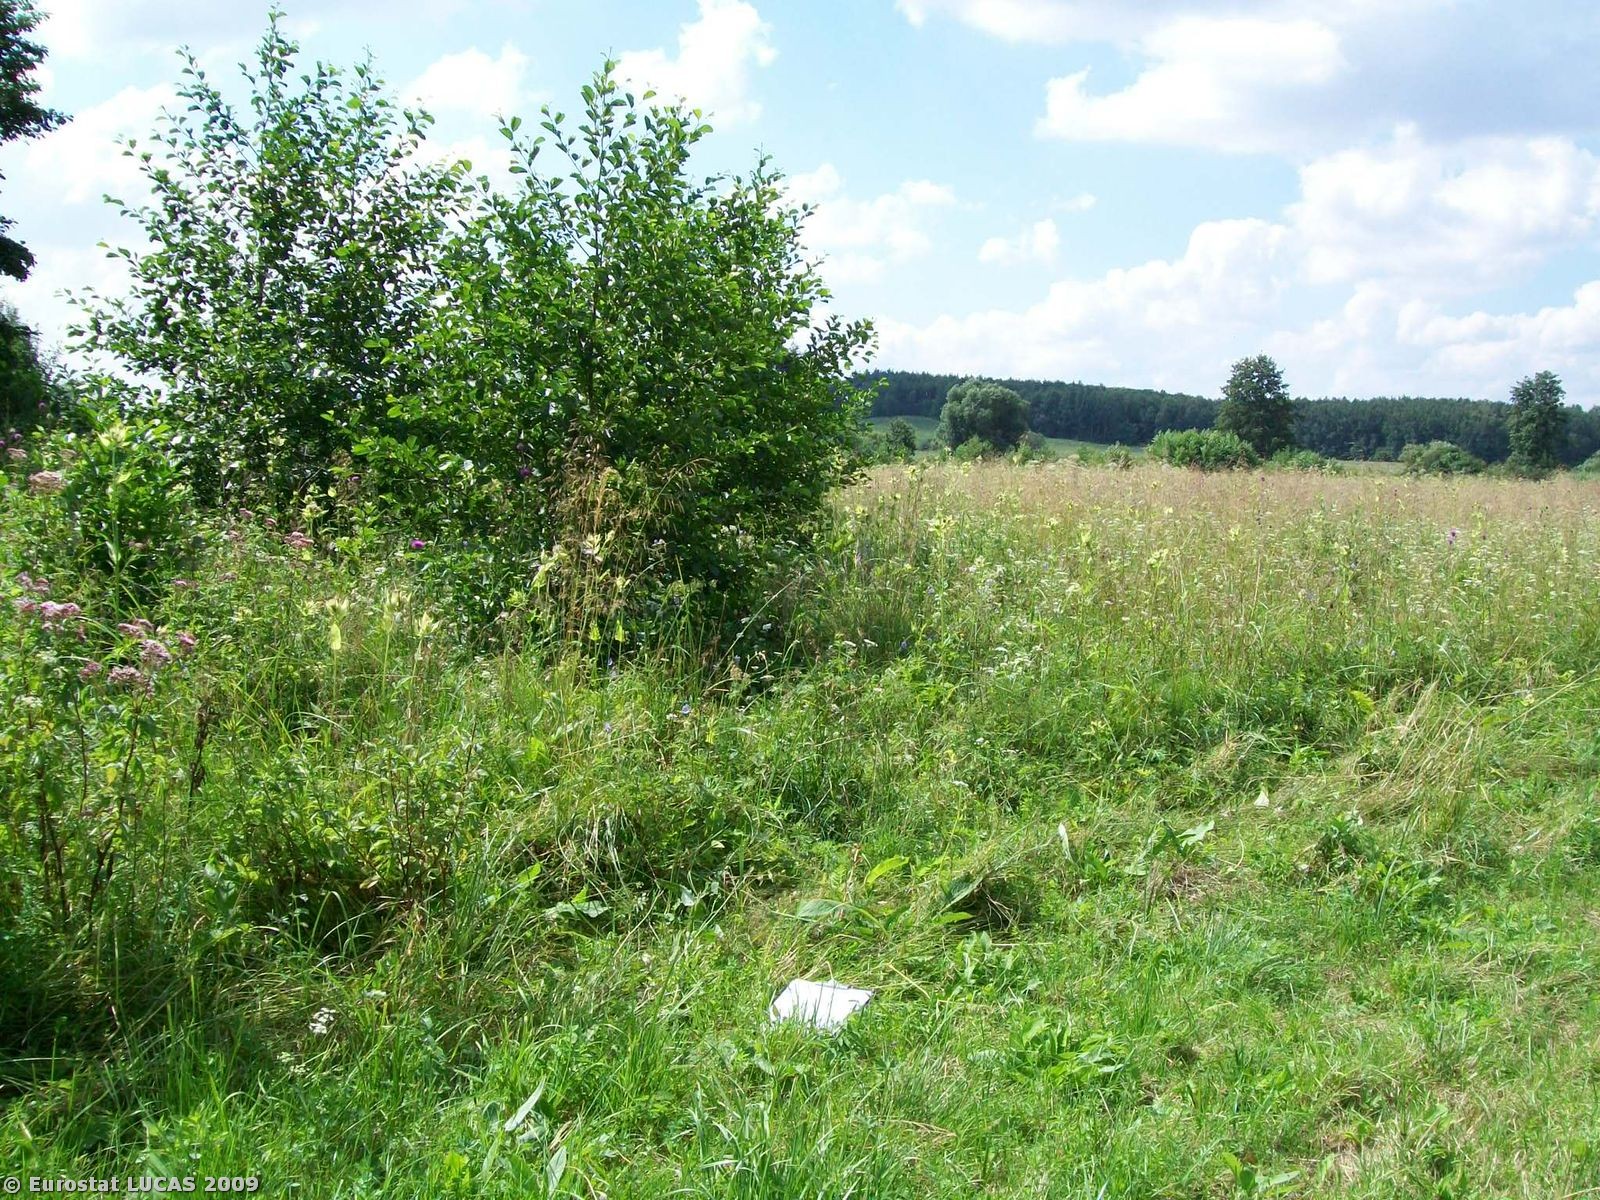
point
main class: Grassland
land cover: Grassland without tree/shrub cover
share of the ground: > 75 %
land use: Agriculture (excluding fallow land and kitchen gardens)
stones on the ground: < 10 %
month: August
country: PL
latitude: 50.7946
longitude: 16.7762
